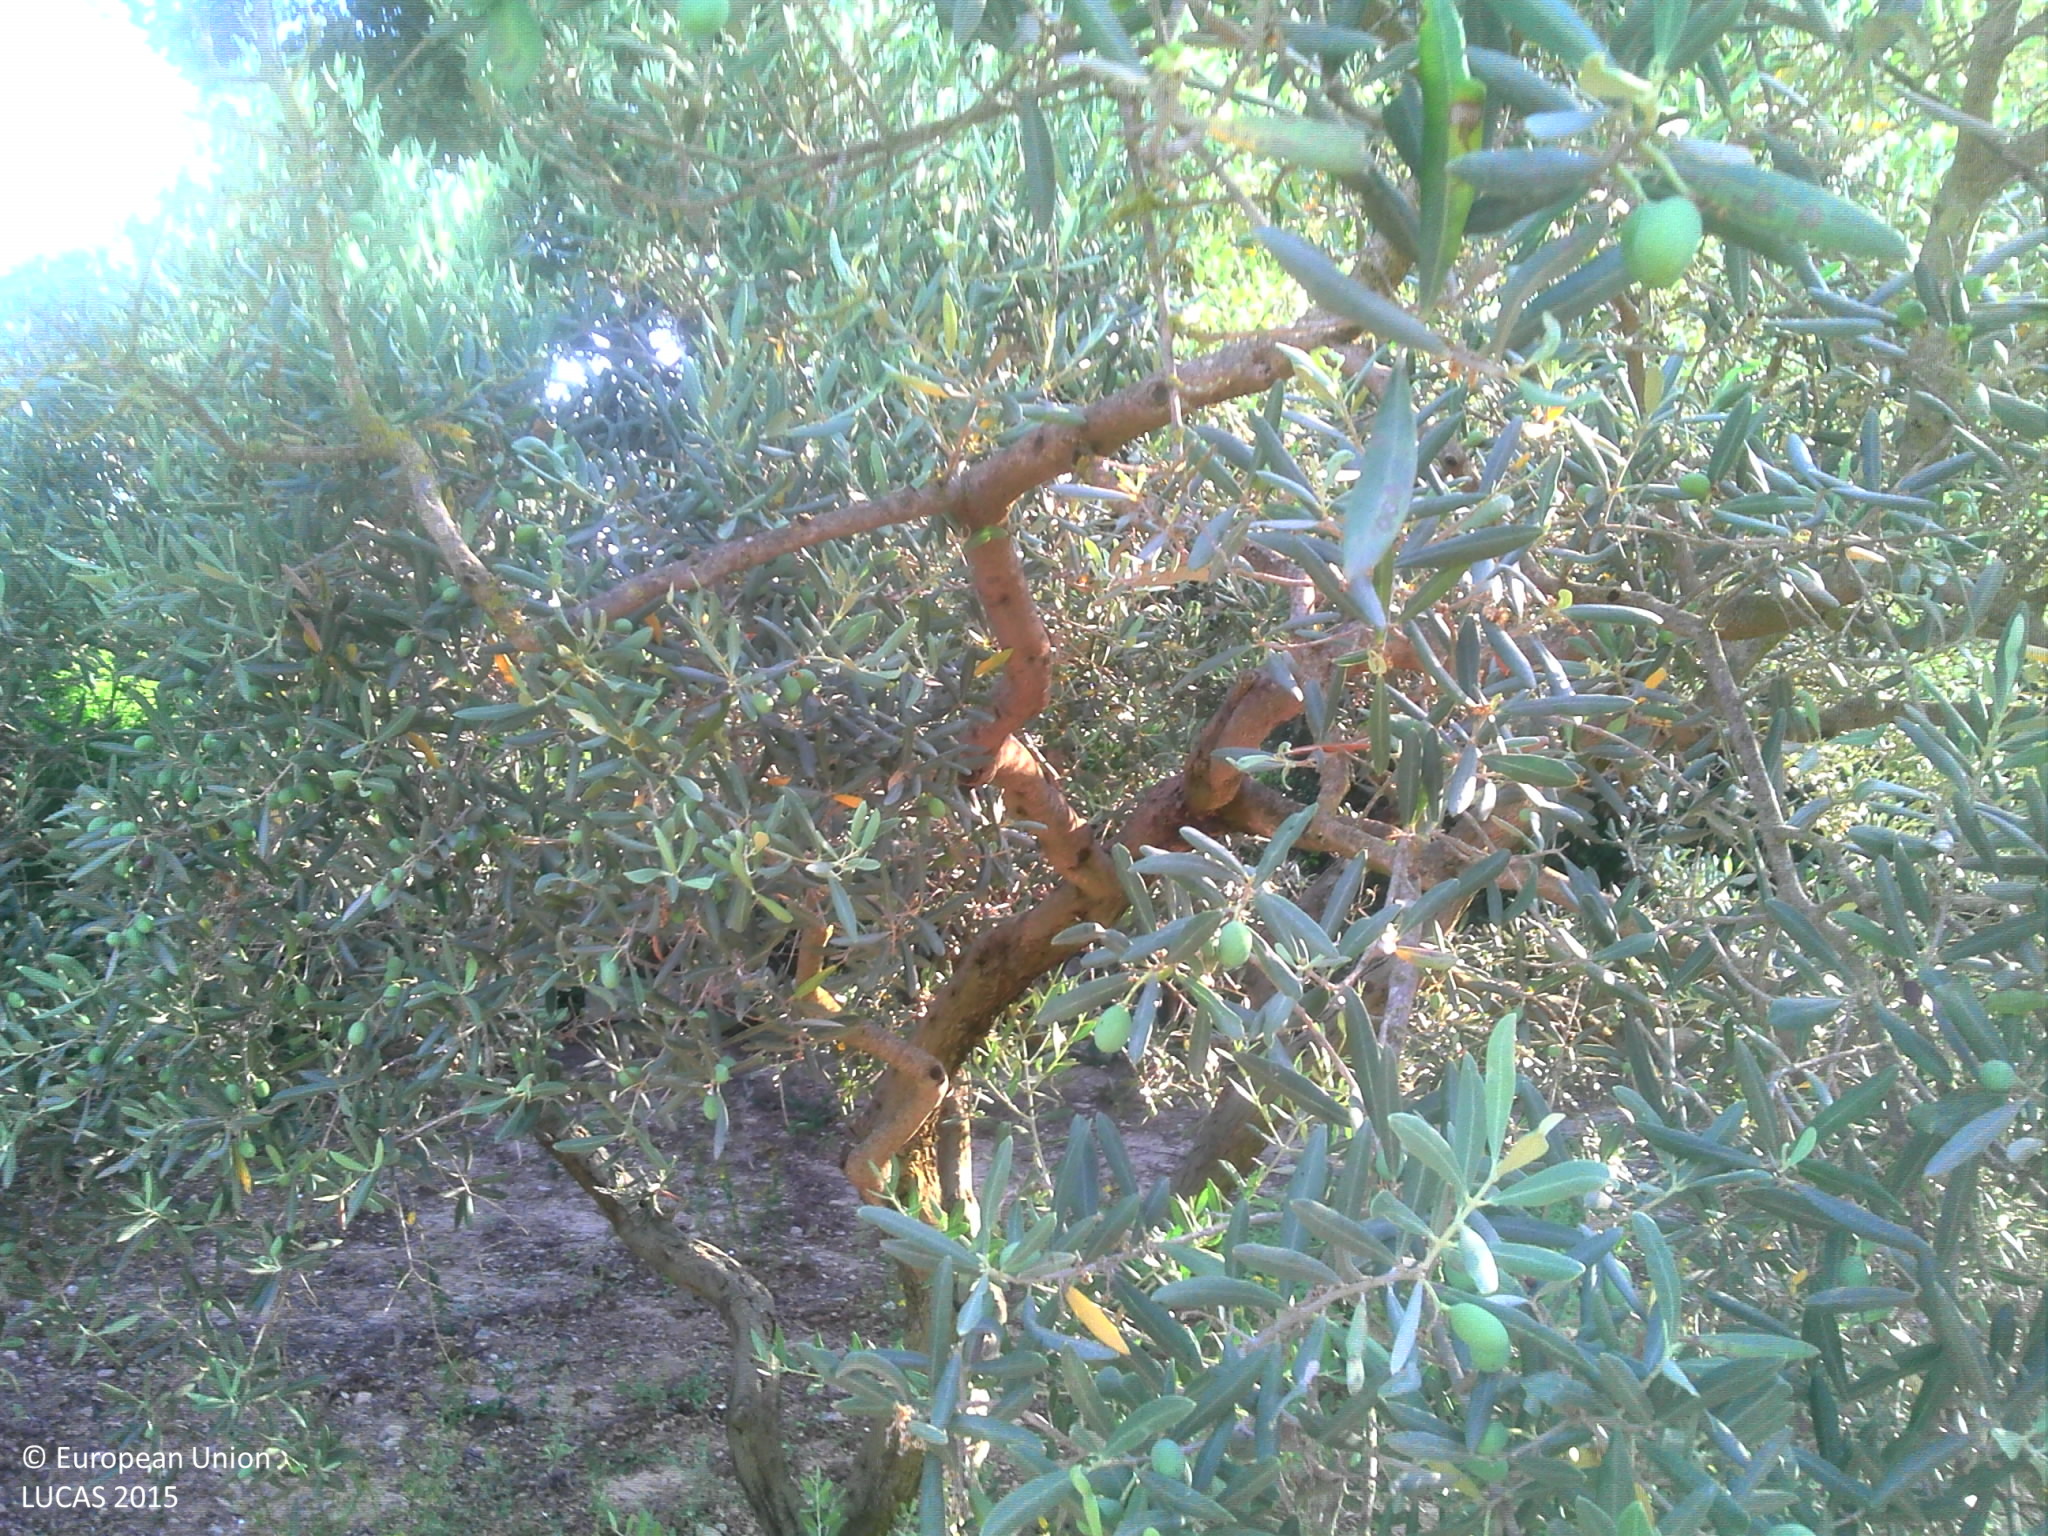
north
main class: Cropland
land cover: Olive groves
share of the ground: 10 - 25 %
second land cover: Other bare soil
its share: > 75 %
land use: Agriculture (excluding fallow land and kitchen gardens)
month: July
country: FR
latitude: 43.6043
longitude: 5.1408
